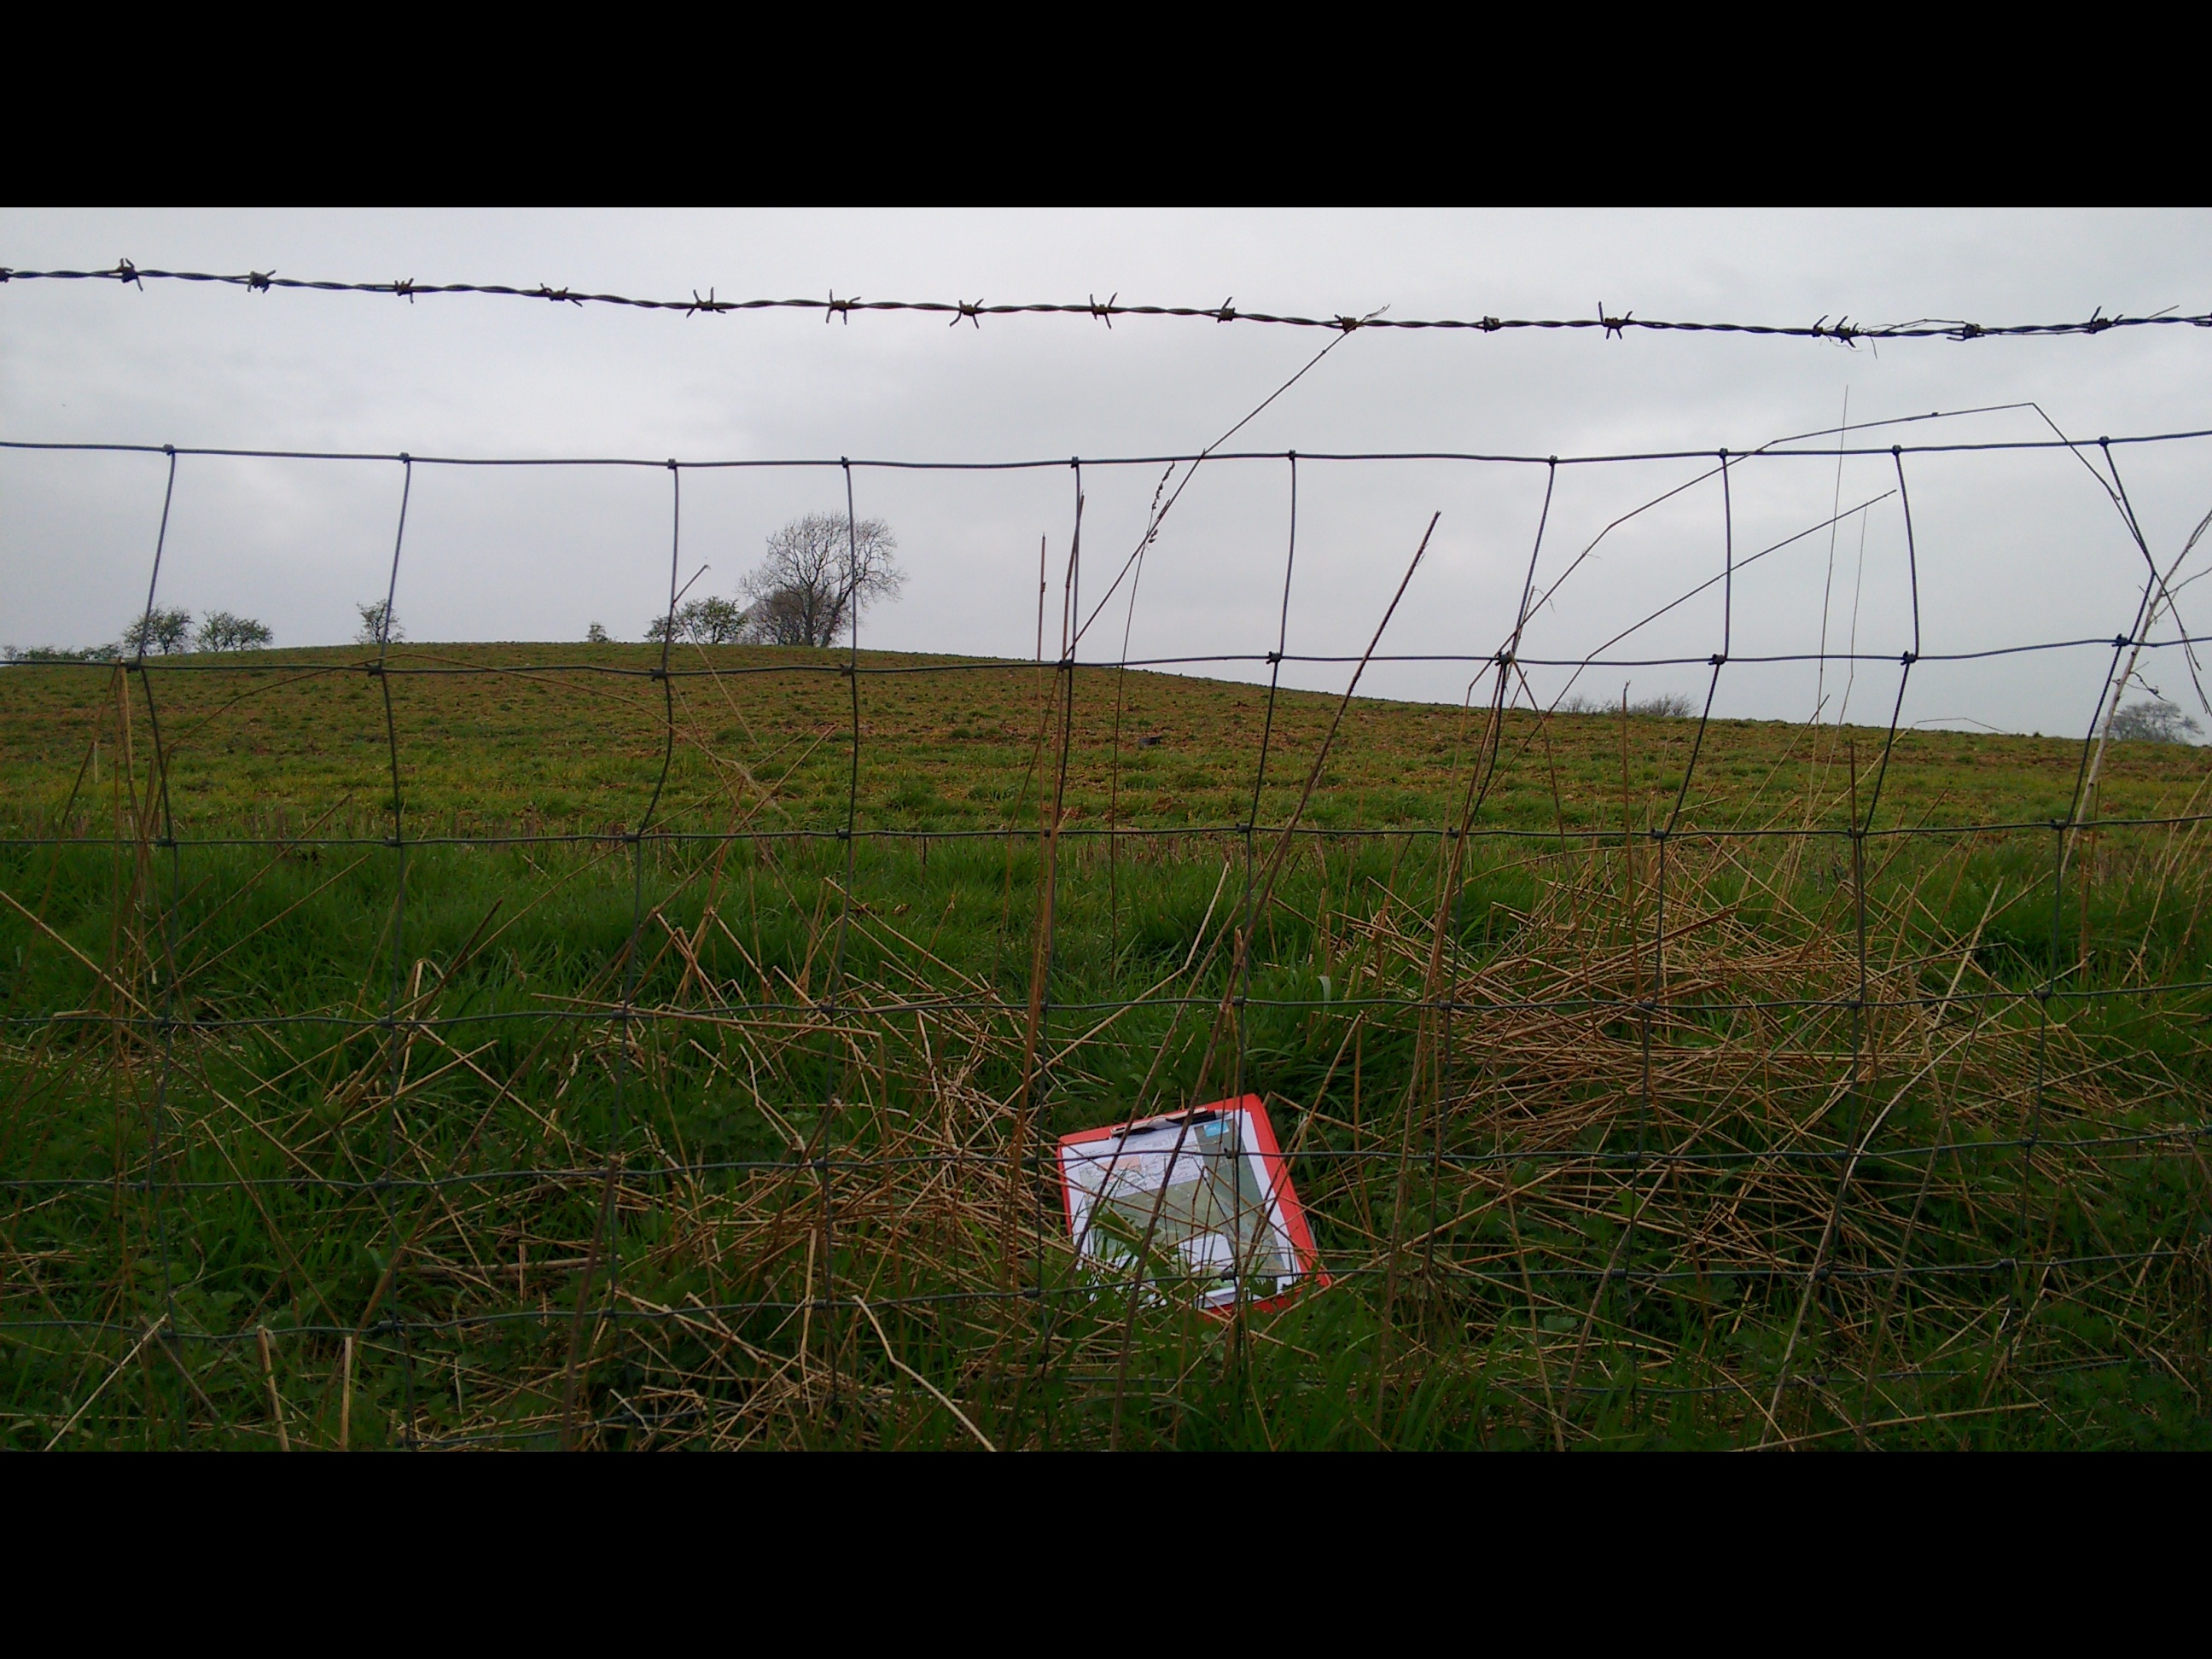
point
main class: Grassland
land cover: Grassland without tree/shrub cover
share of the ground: > 75 %
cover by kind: herbaceous plants 100 %
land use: Agriculture (excluding fallow land and kitchen gardens)
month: April
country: GB
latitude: 53.9464
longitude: -2.2031
